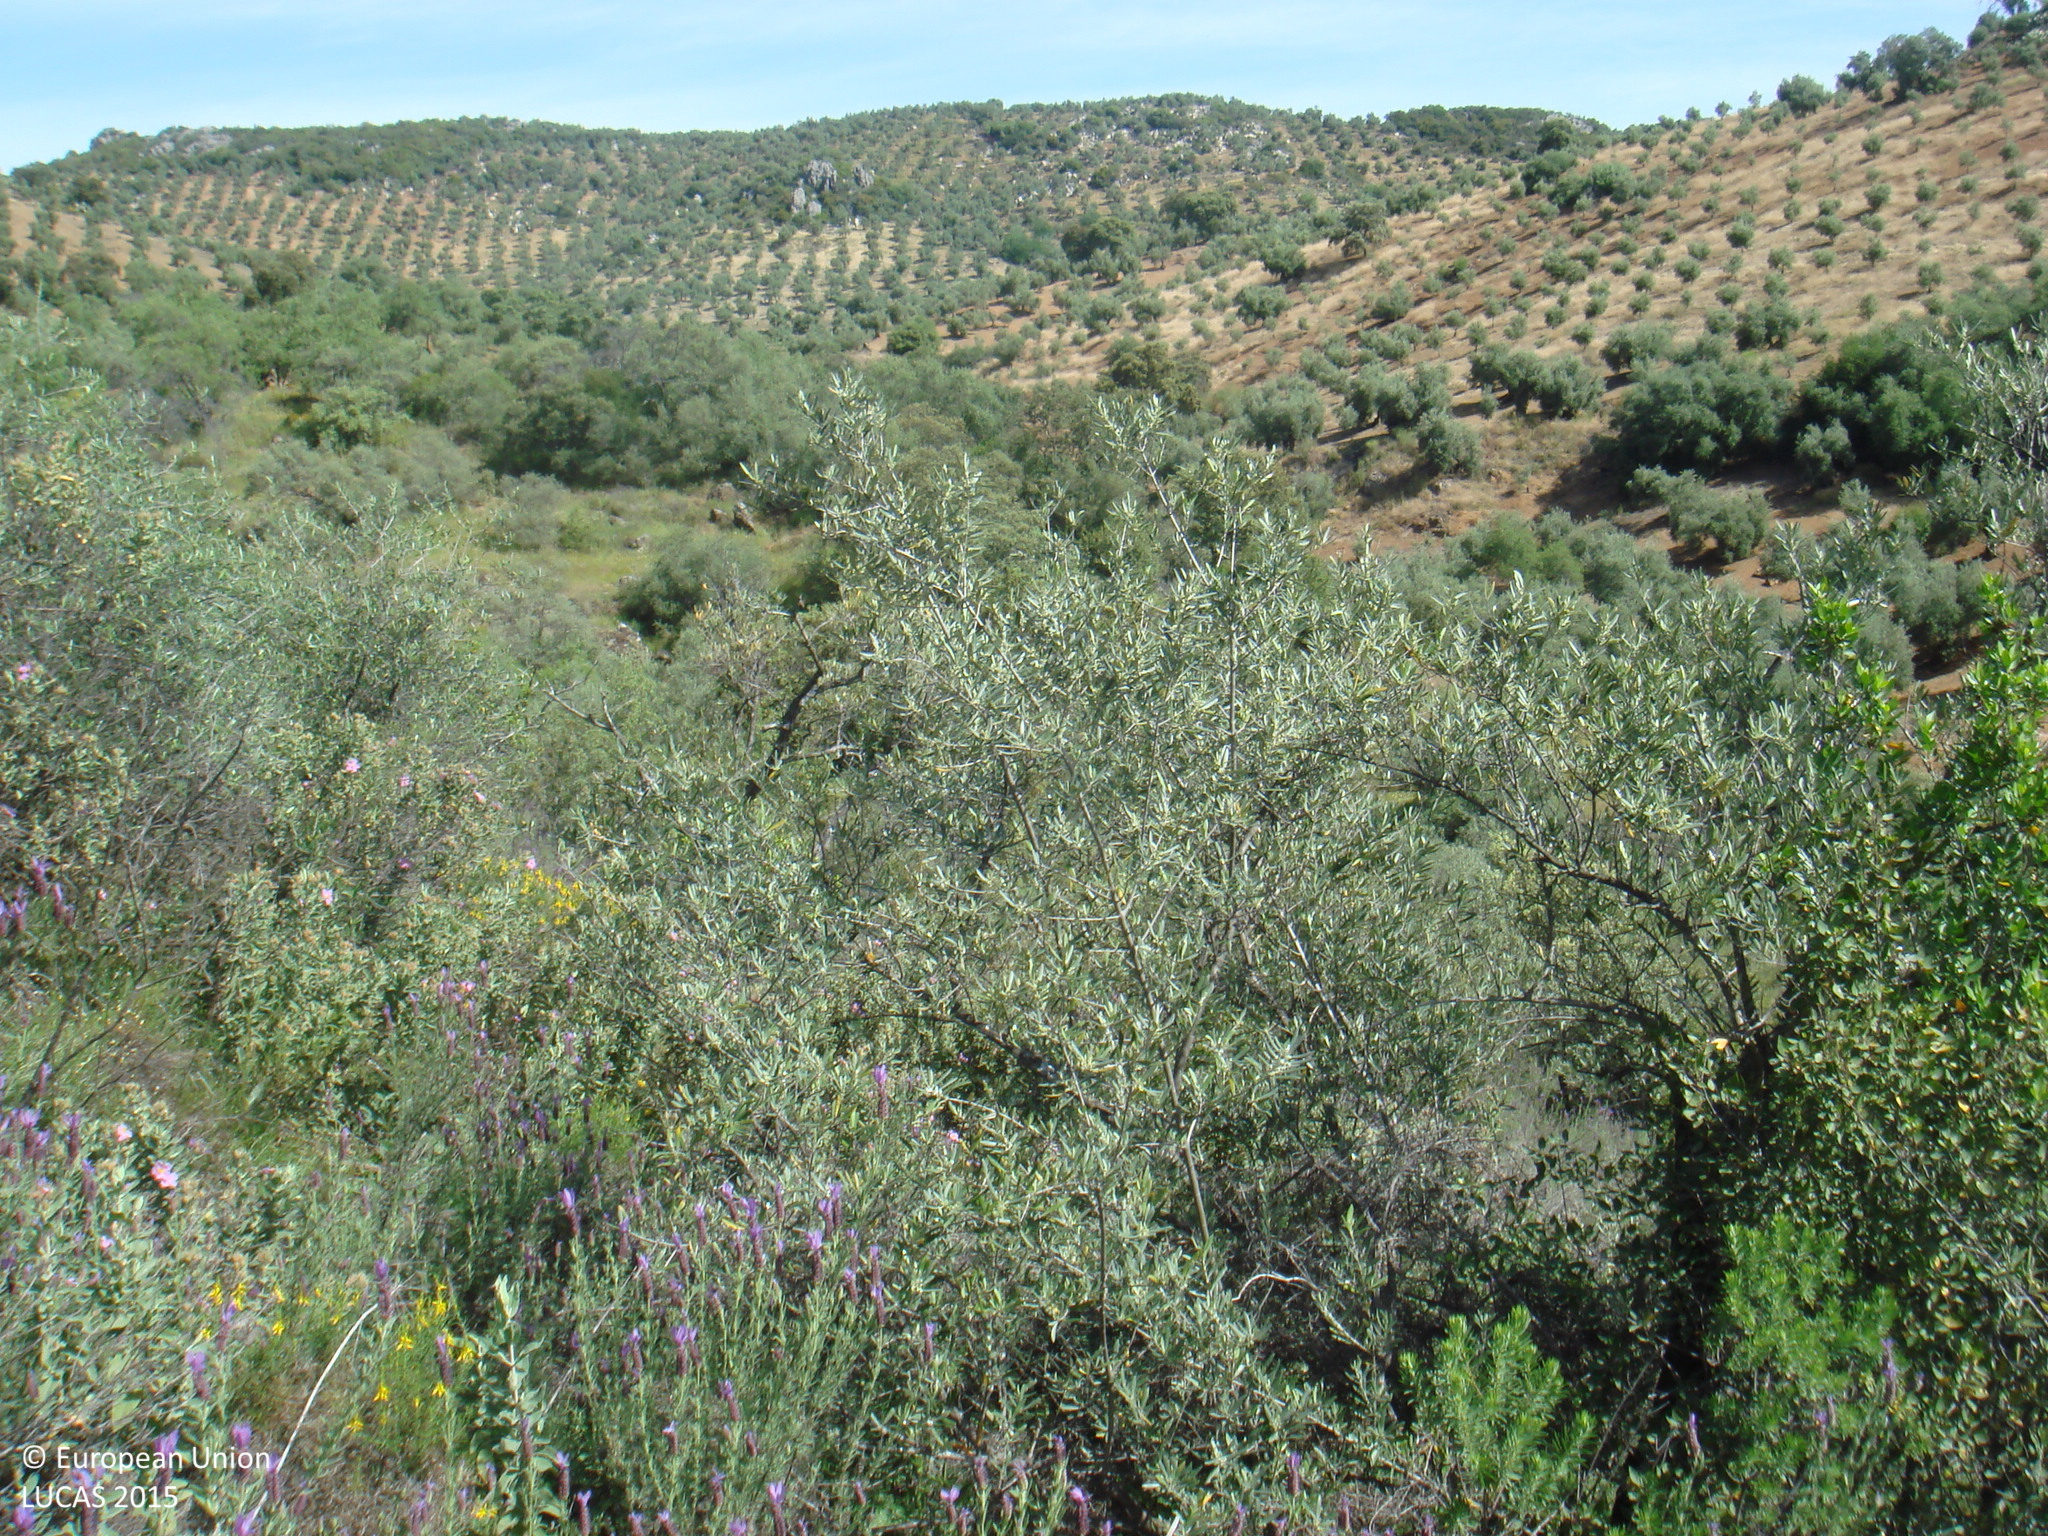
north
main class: Shrubland
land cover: Shrubland with sparse tree cover
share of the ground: > 75 %
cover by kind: shrubs 65 %, herbaceous plants 30 %, broadleaved forest trees 5 %
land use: Agriculture (excluding fallow land and kitchen gardens)
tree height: < 5 m
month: April
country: ES
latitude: 38.0642
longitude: -4.6159
